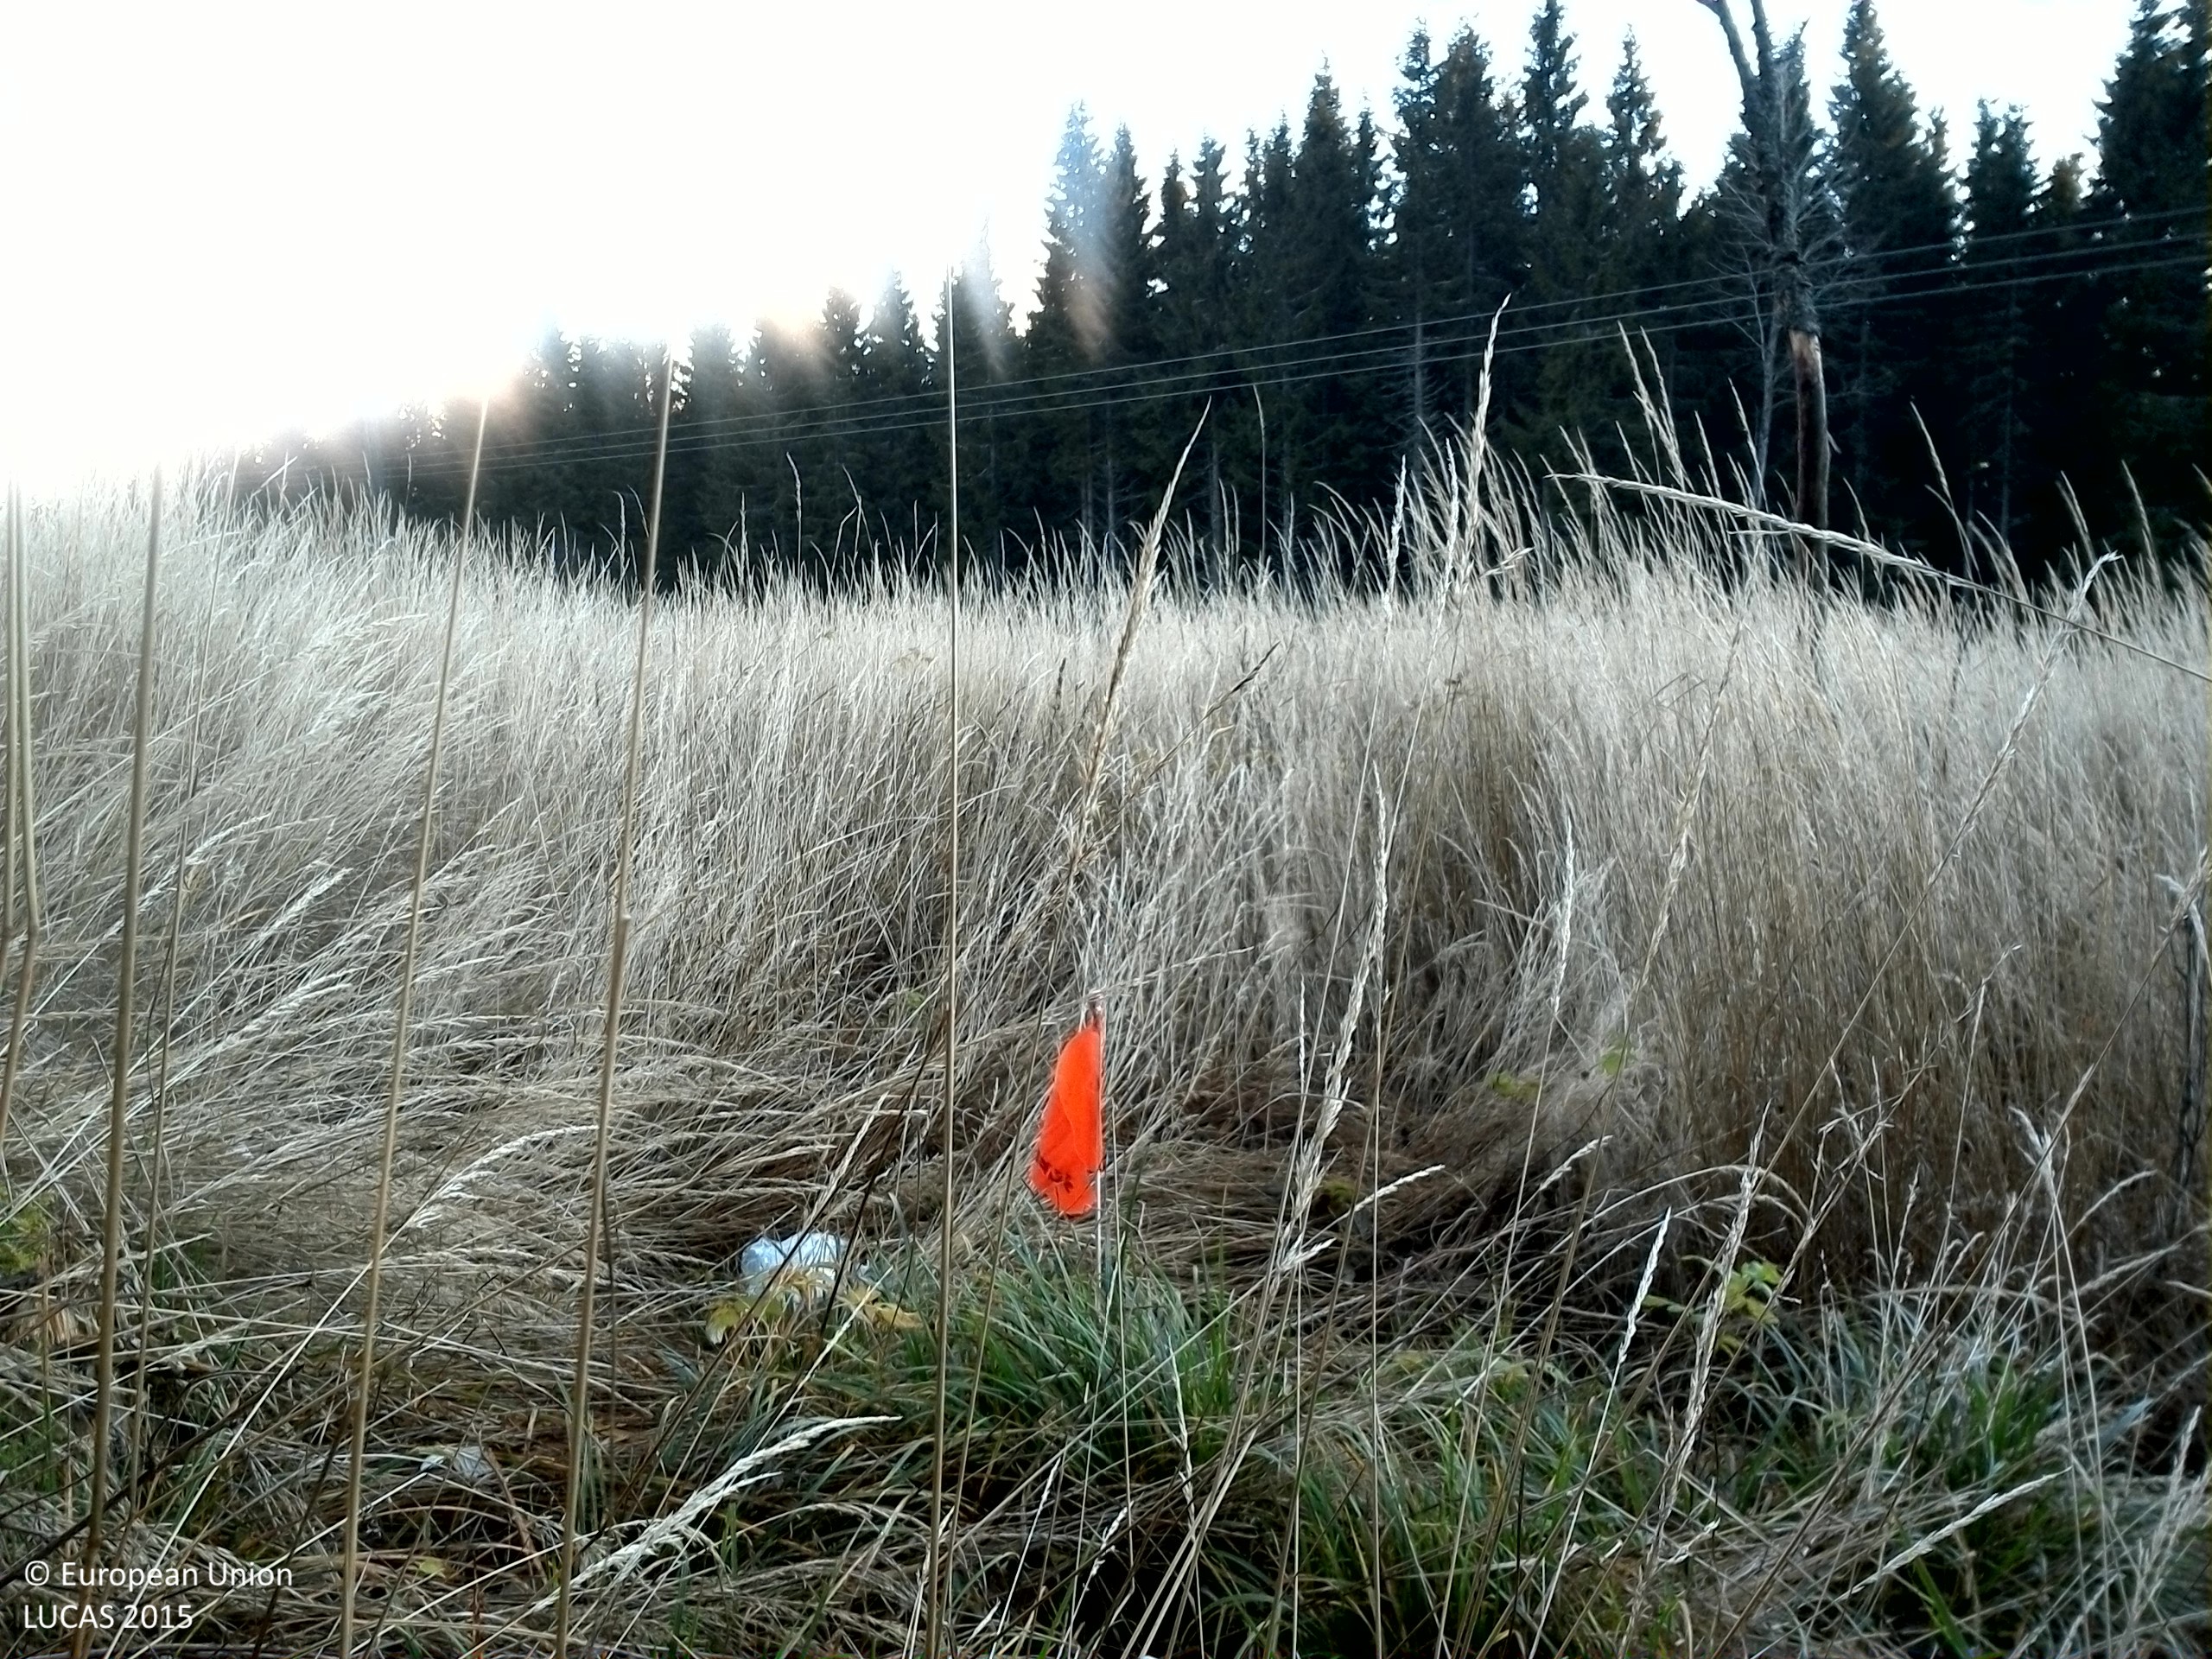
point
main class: Grassland
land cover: Grassland with sparse tree/shrub cover
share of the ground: > 75 %
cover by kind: herbaceous plants 95 %, coniferous forest trees 5 %
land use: Electricity, gas and thermal power distribution
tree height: < 5 m
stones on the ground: < 10 %
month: November
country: SE
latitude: 60.0521
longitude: 15.1074
